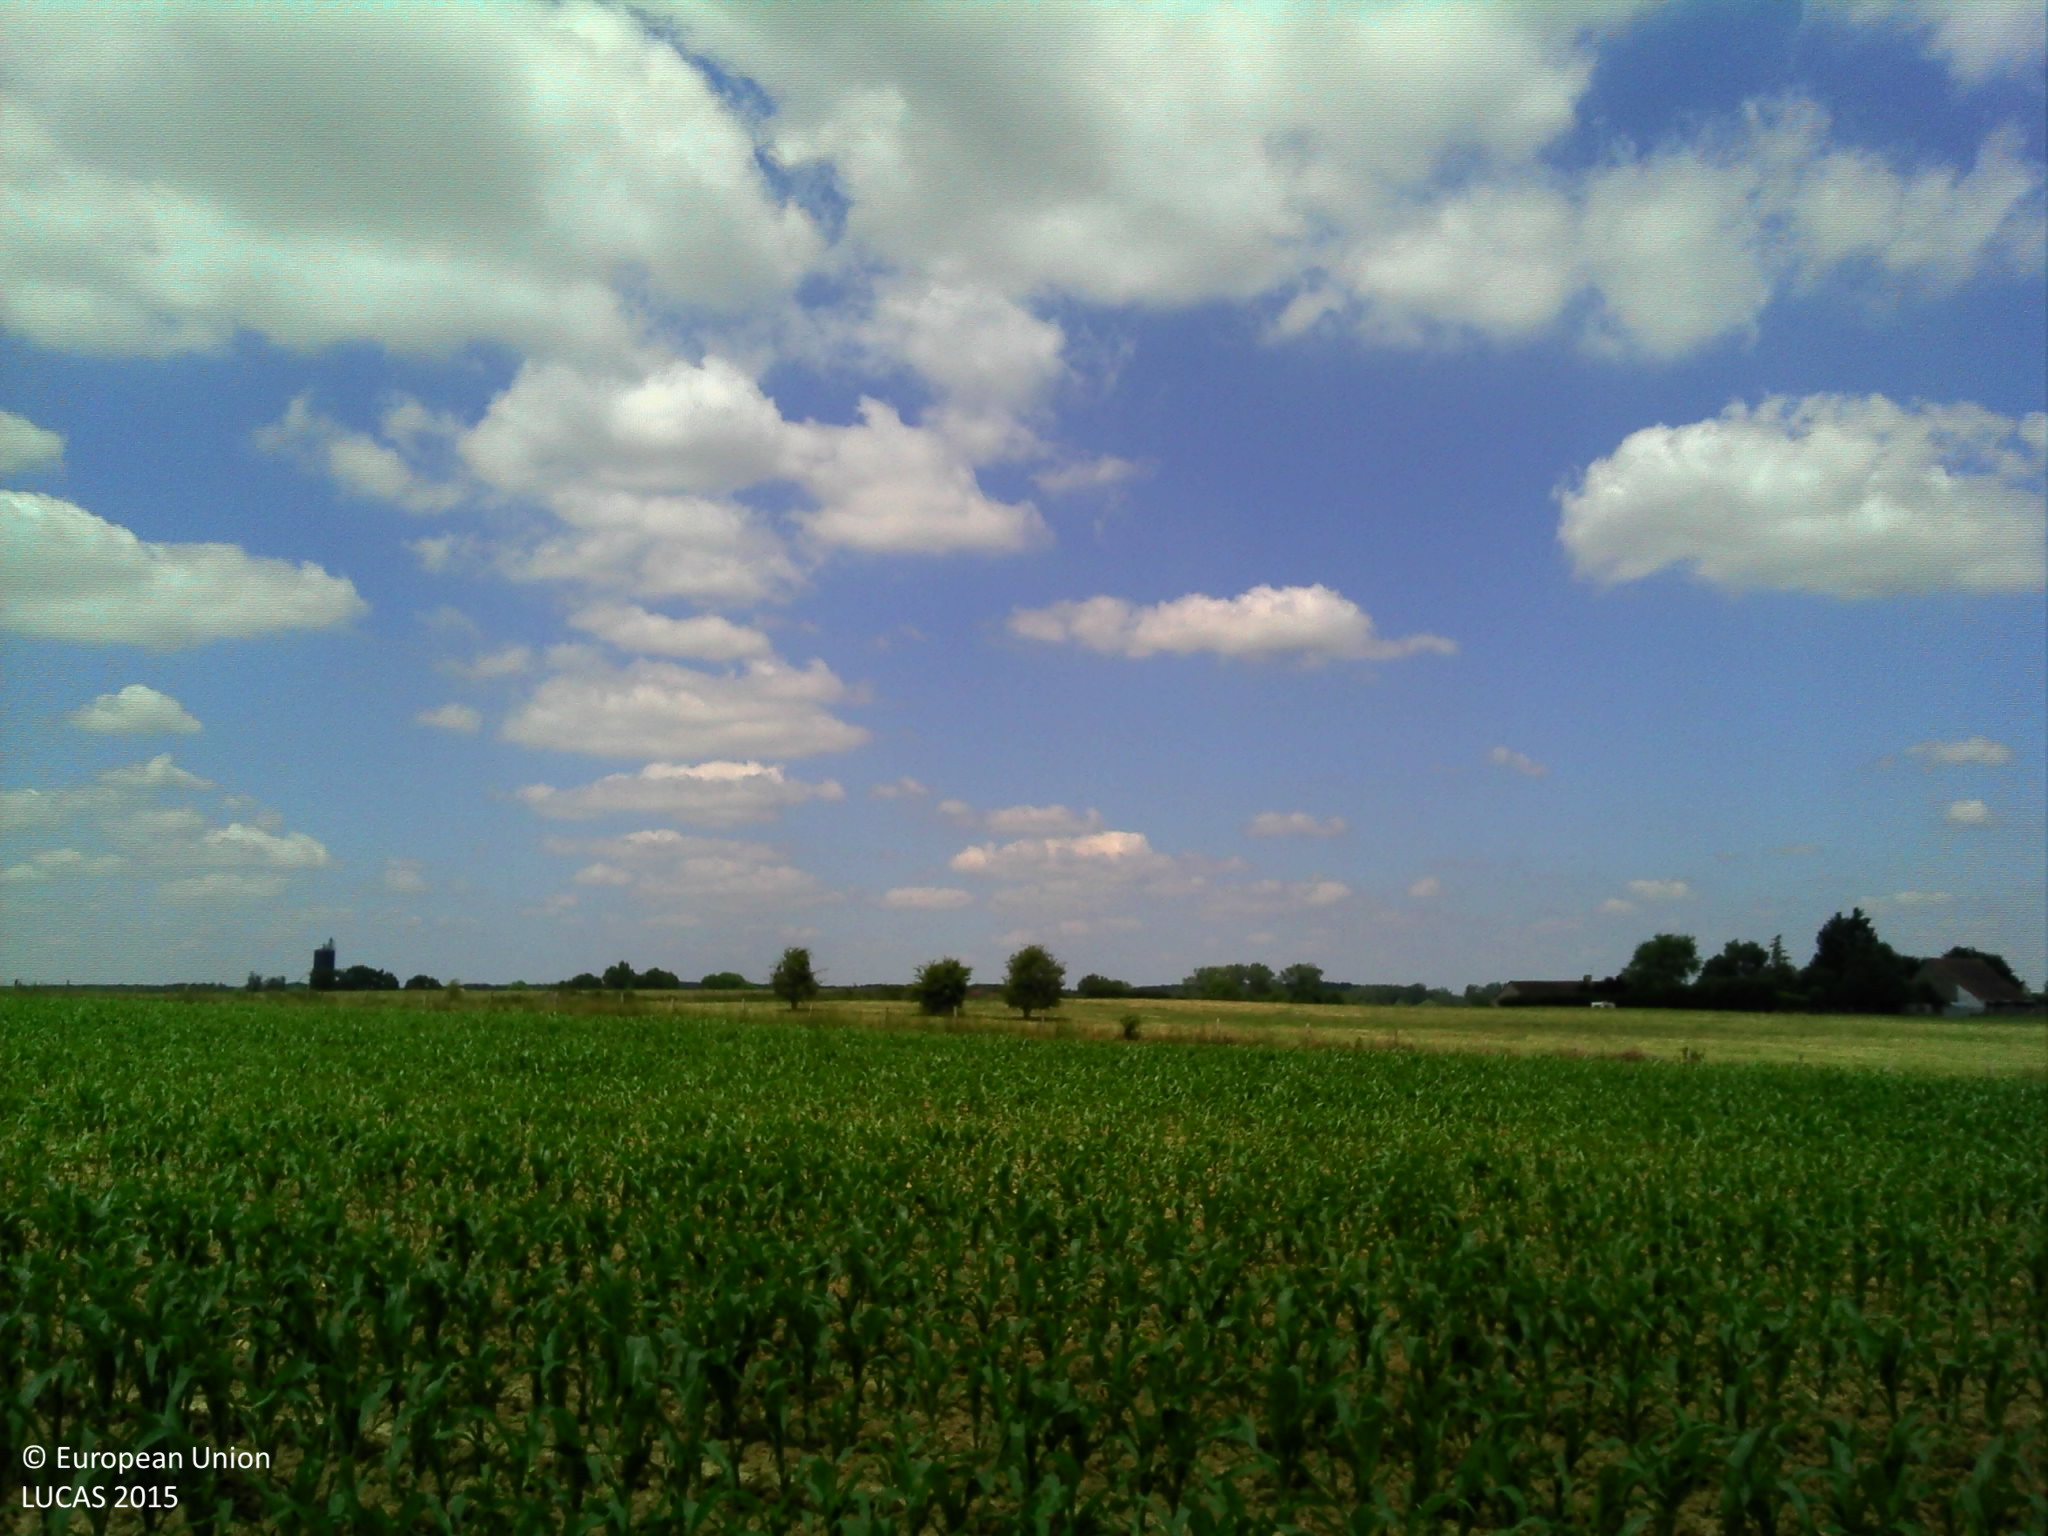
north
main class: Cropland
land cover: Maize
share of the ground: 25 - 50 %
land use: Agriculture (excluding fallow land and kitchen gardens)
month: June
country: FR
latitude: 48.2732
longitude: 0.1774
